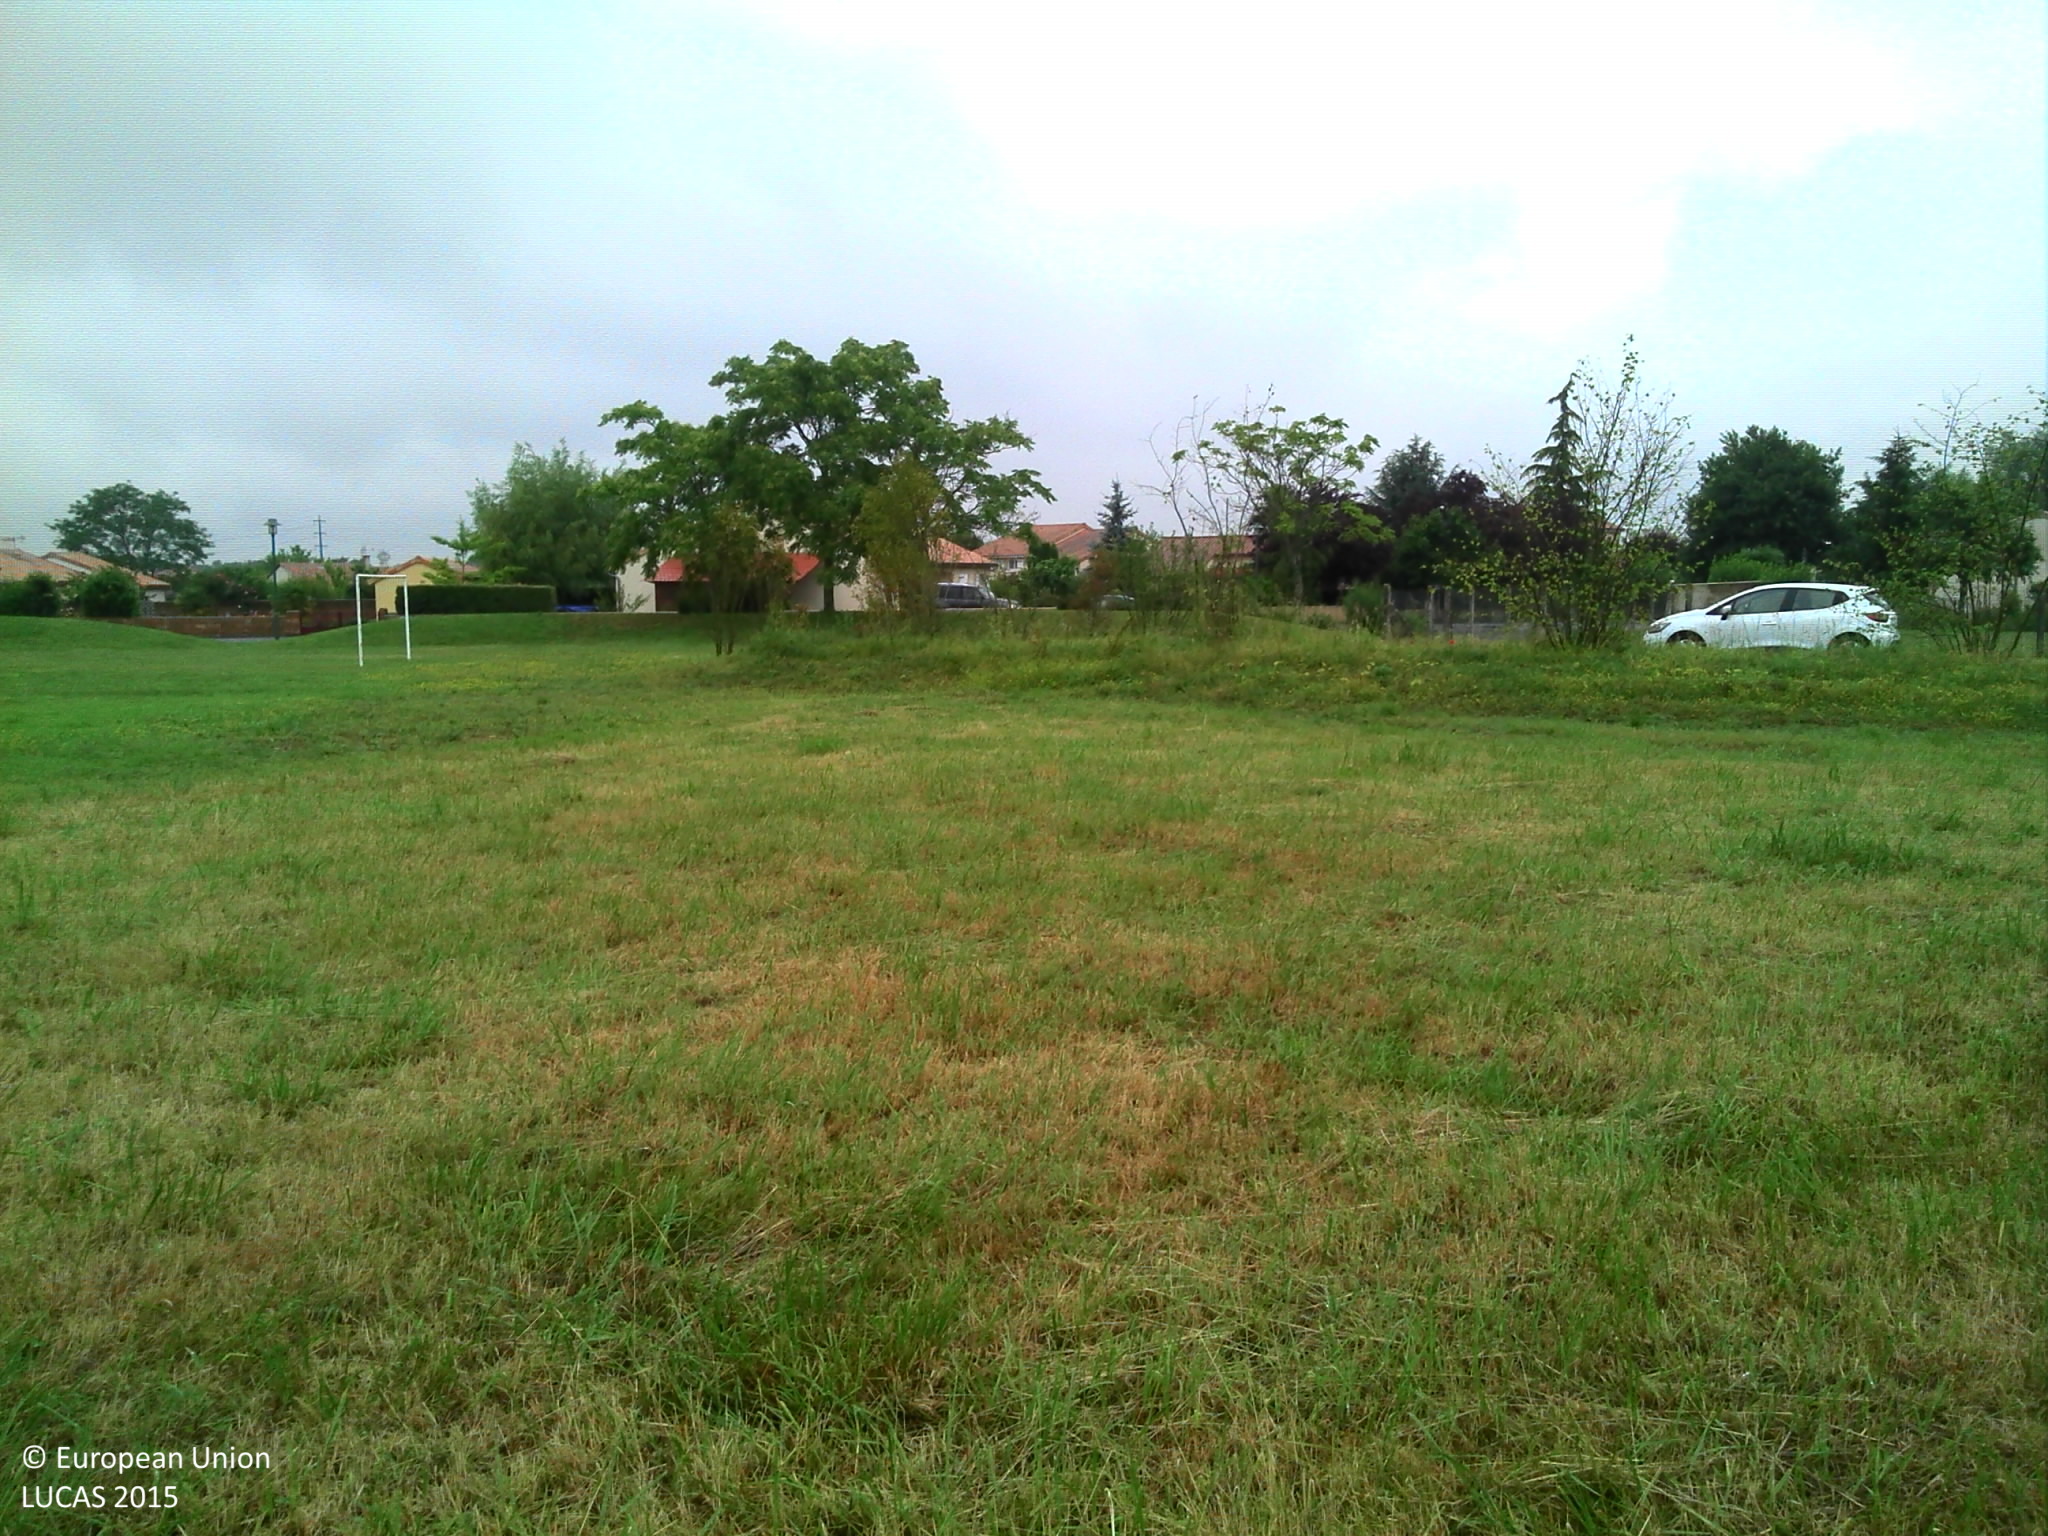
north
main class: Grassland
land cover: Grassland without tree/shrub cover
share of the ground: > 75 %
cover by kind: herbaceous plants 100 %
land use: Agriculture (excluding fallow land and kitchen gardens)
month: June
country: FR
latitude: 46.5433
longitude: 0.2915
